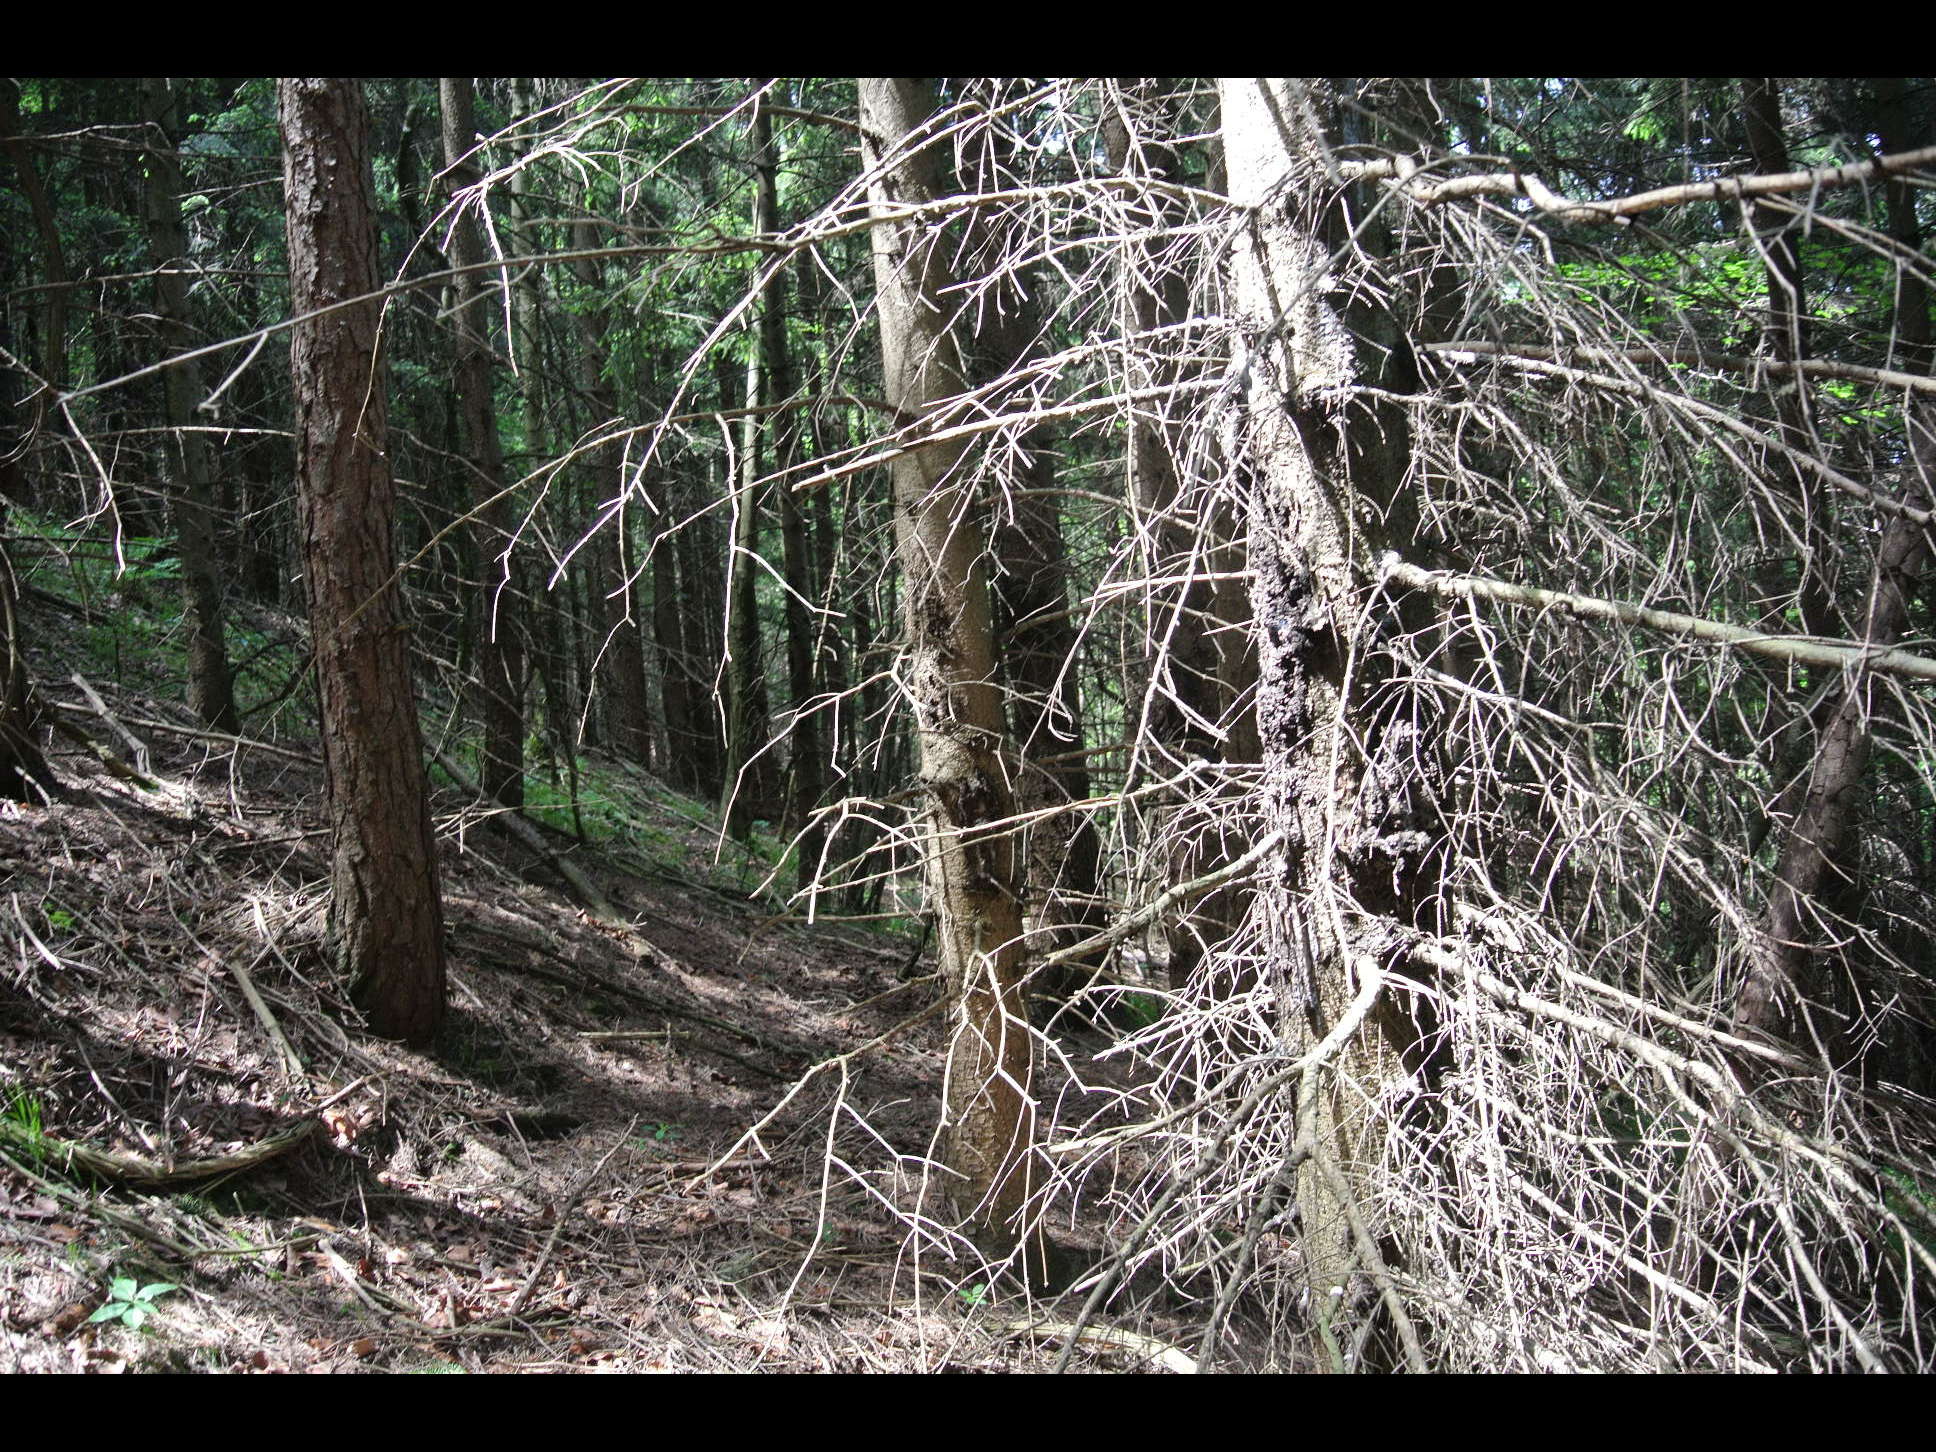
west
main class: Woodland
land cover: Spruce dominated coniferous woodland
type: alpine coniferous forest
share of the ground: > 75 %
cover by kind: coniferous forest trees 95 %, broadleaved forest trees 5 %
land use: Forestry
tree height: > 5 m
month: May
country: AT
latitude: 47.9970
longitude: 15.8326
